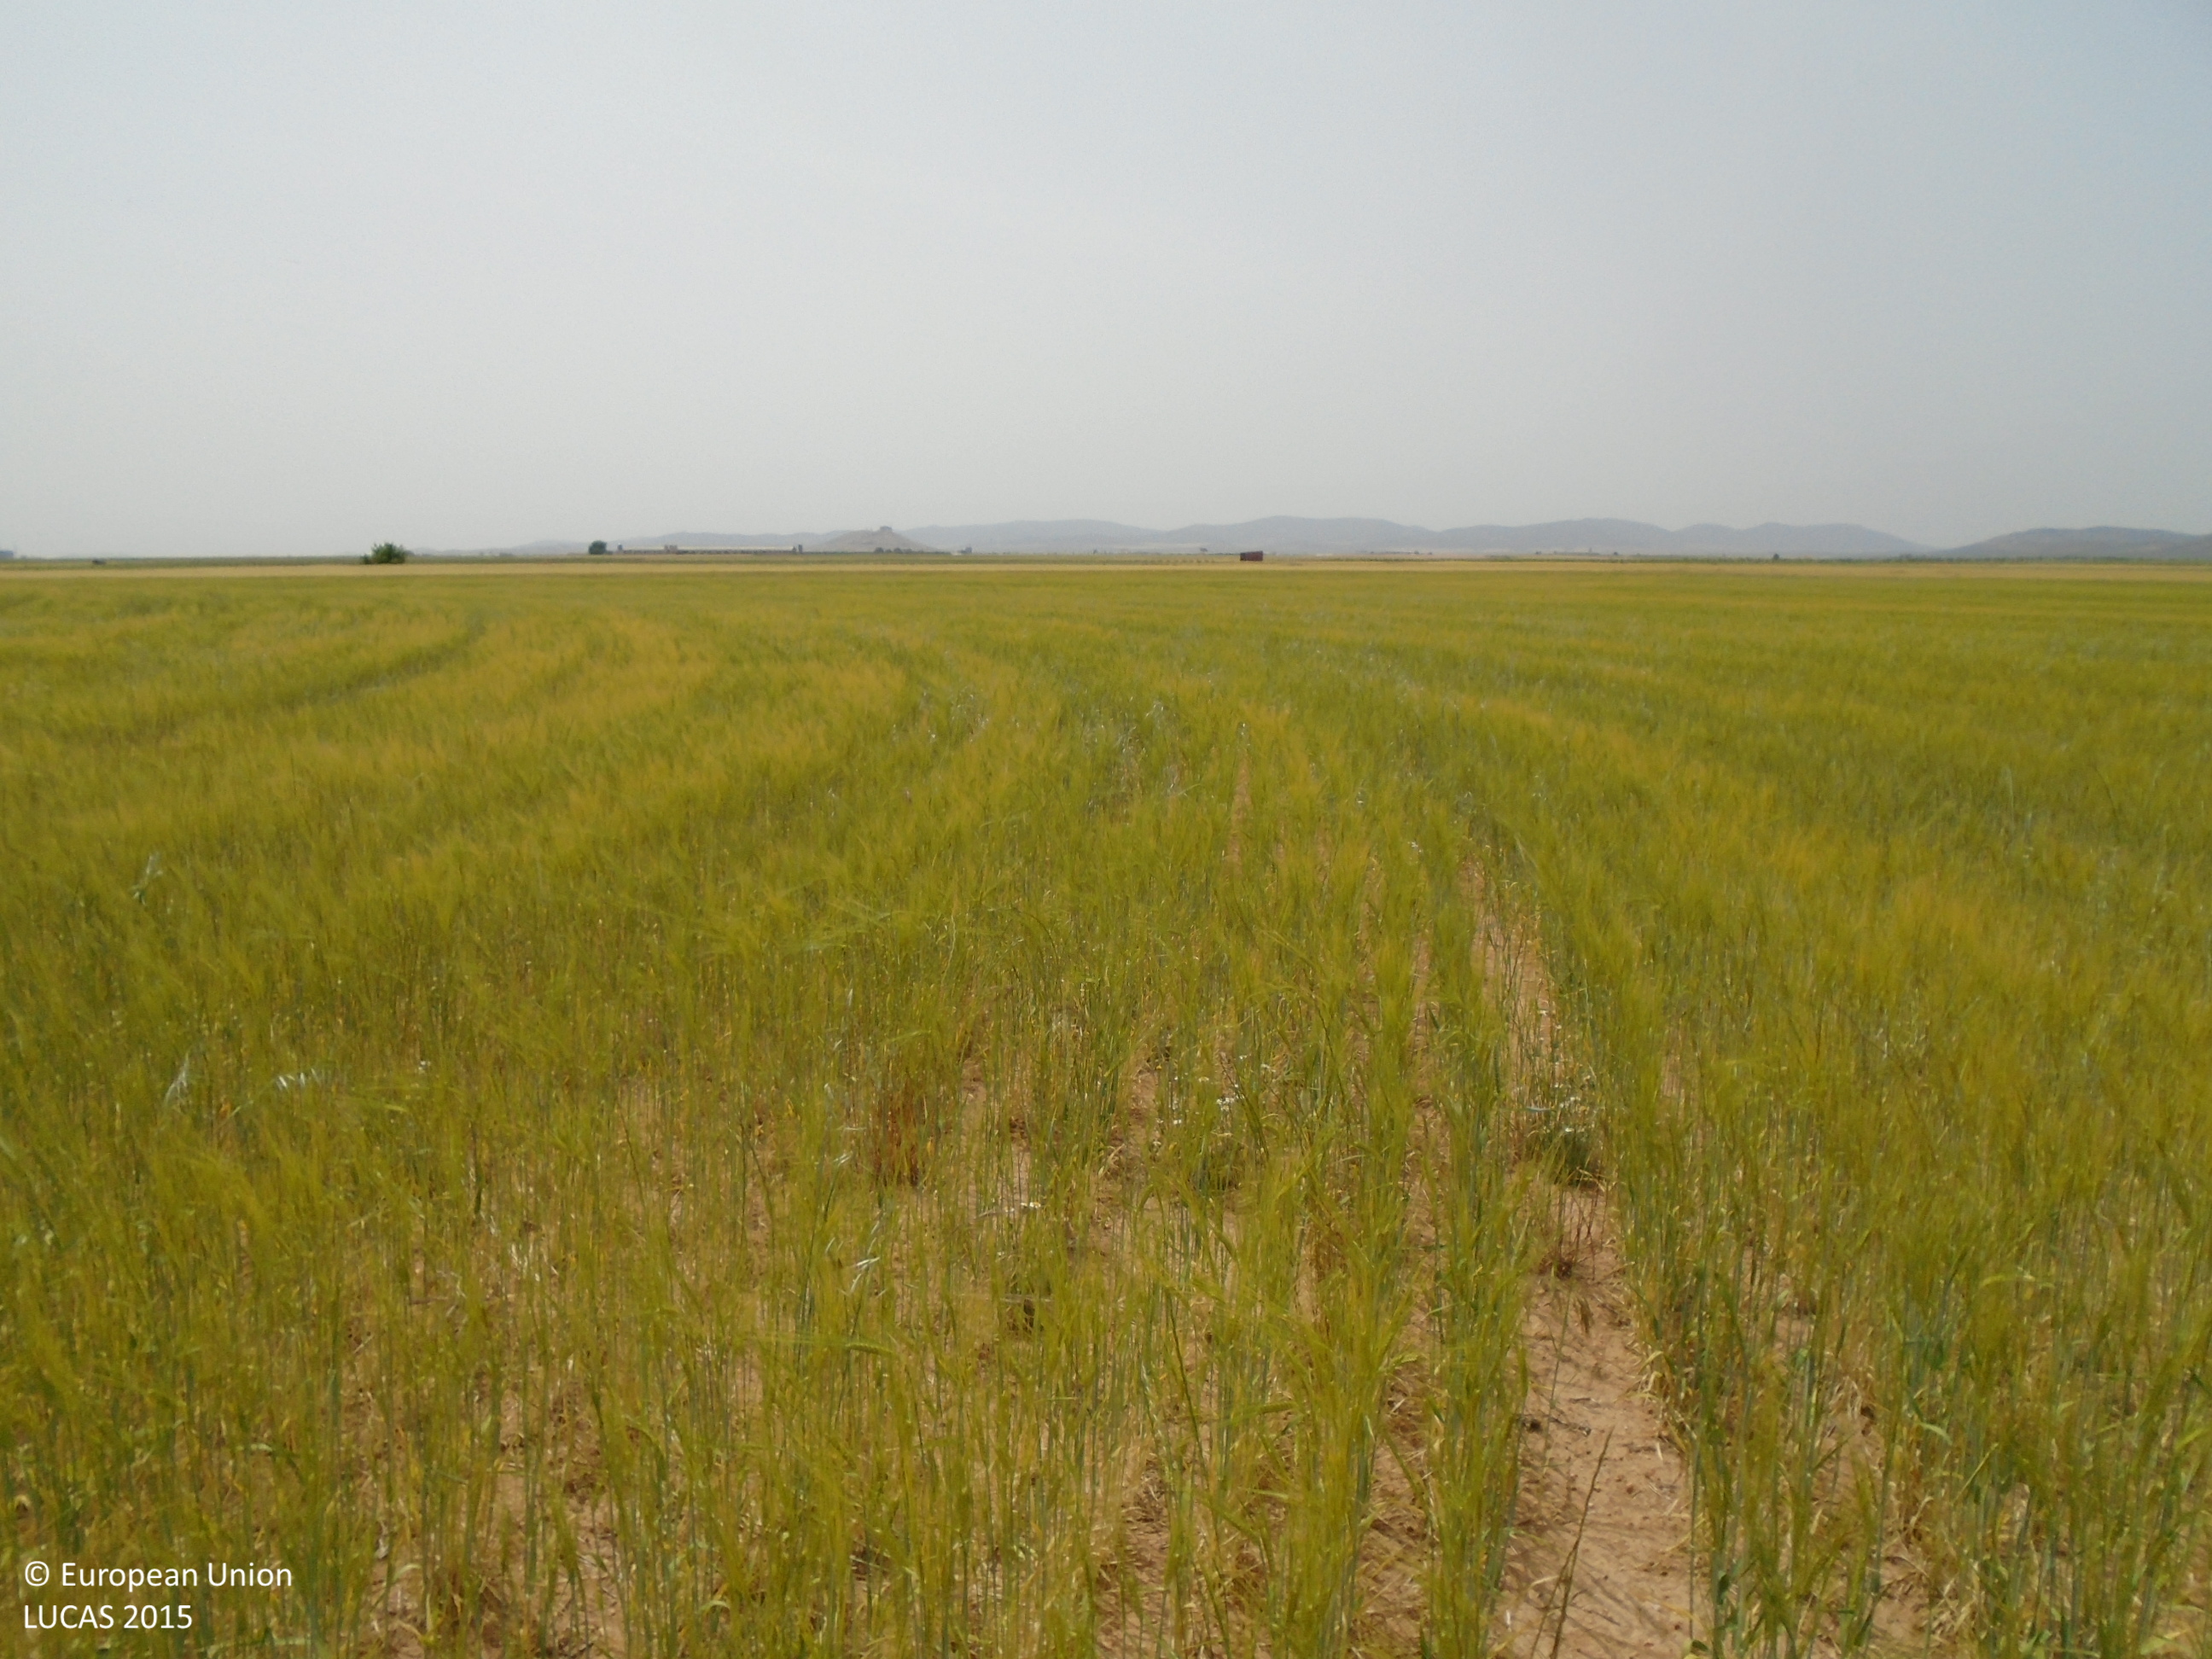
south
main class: Cropland
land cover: Barley
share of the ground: > 75 %
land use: Agriculture (excluding fallow land and kitchen gardens)
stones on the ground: < 10 %
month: May
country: ES
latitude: 39.5140
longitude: -3.6213
